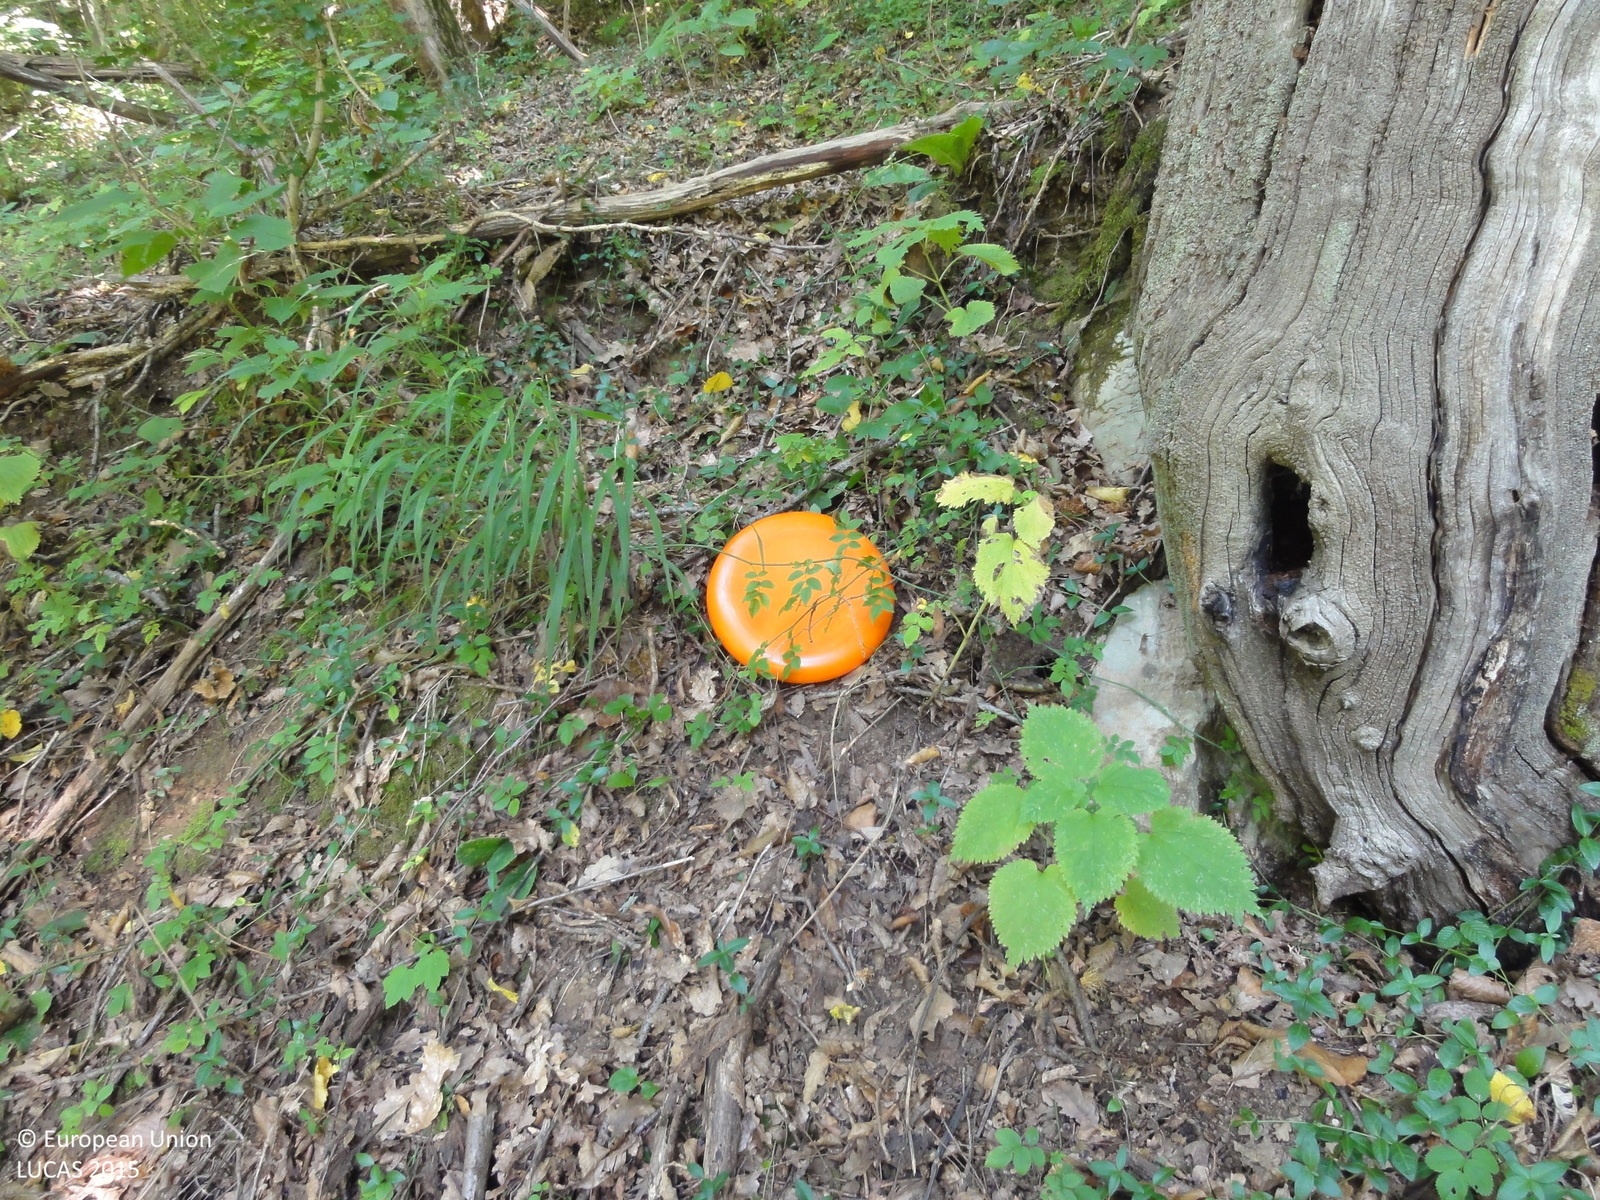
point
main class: Woodland
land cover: Broadleaved woodland
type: mesophytic deciduous forest
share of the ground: > 75 %
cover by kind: broadleaved forest trees 100 %
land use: Semi-natural and natural areas not in use
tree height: > 5 m
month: August
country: SI
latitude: 46.1101
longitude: 13.6061
